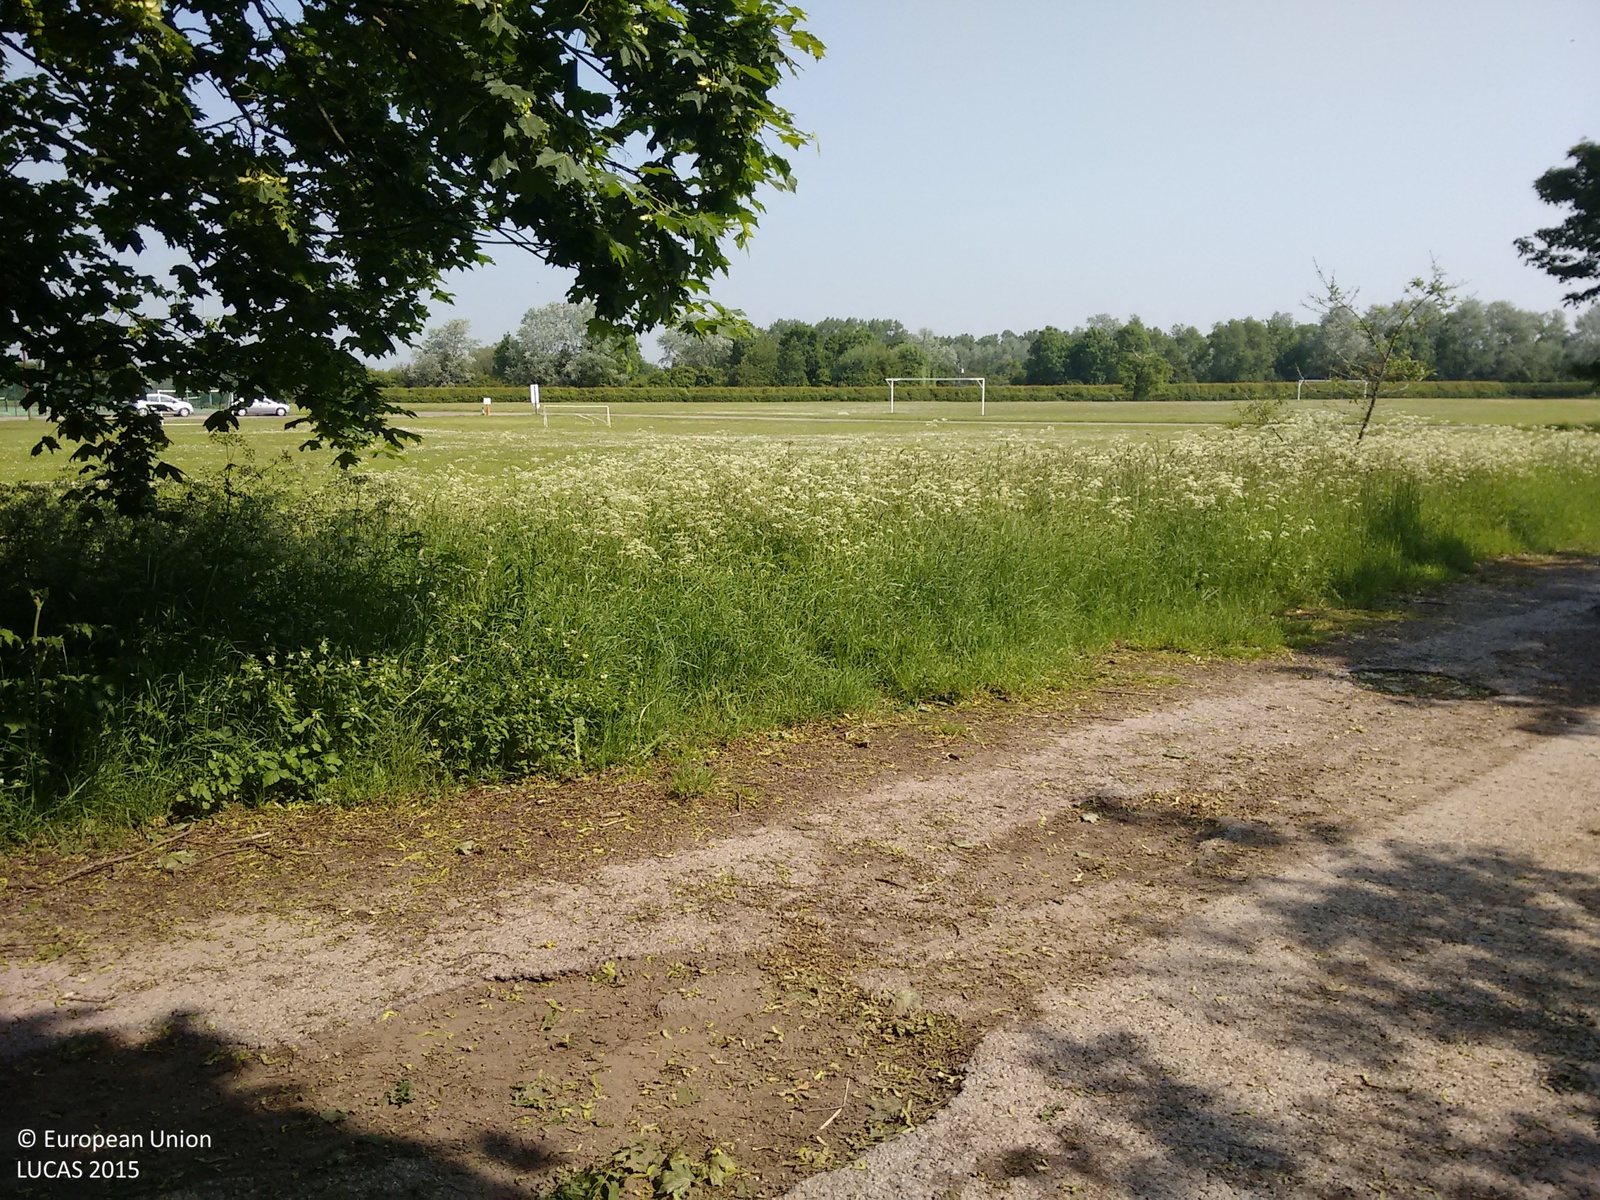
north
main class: Woodland
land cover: Broadleaved woodland
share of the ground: > 75 %
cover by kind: broadleaved forest trees 100 %
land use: Semi-natural and natural areas not in use
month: June
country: GB
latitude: 53.9533
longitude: -1.1845
